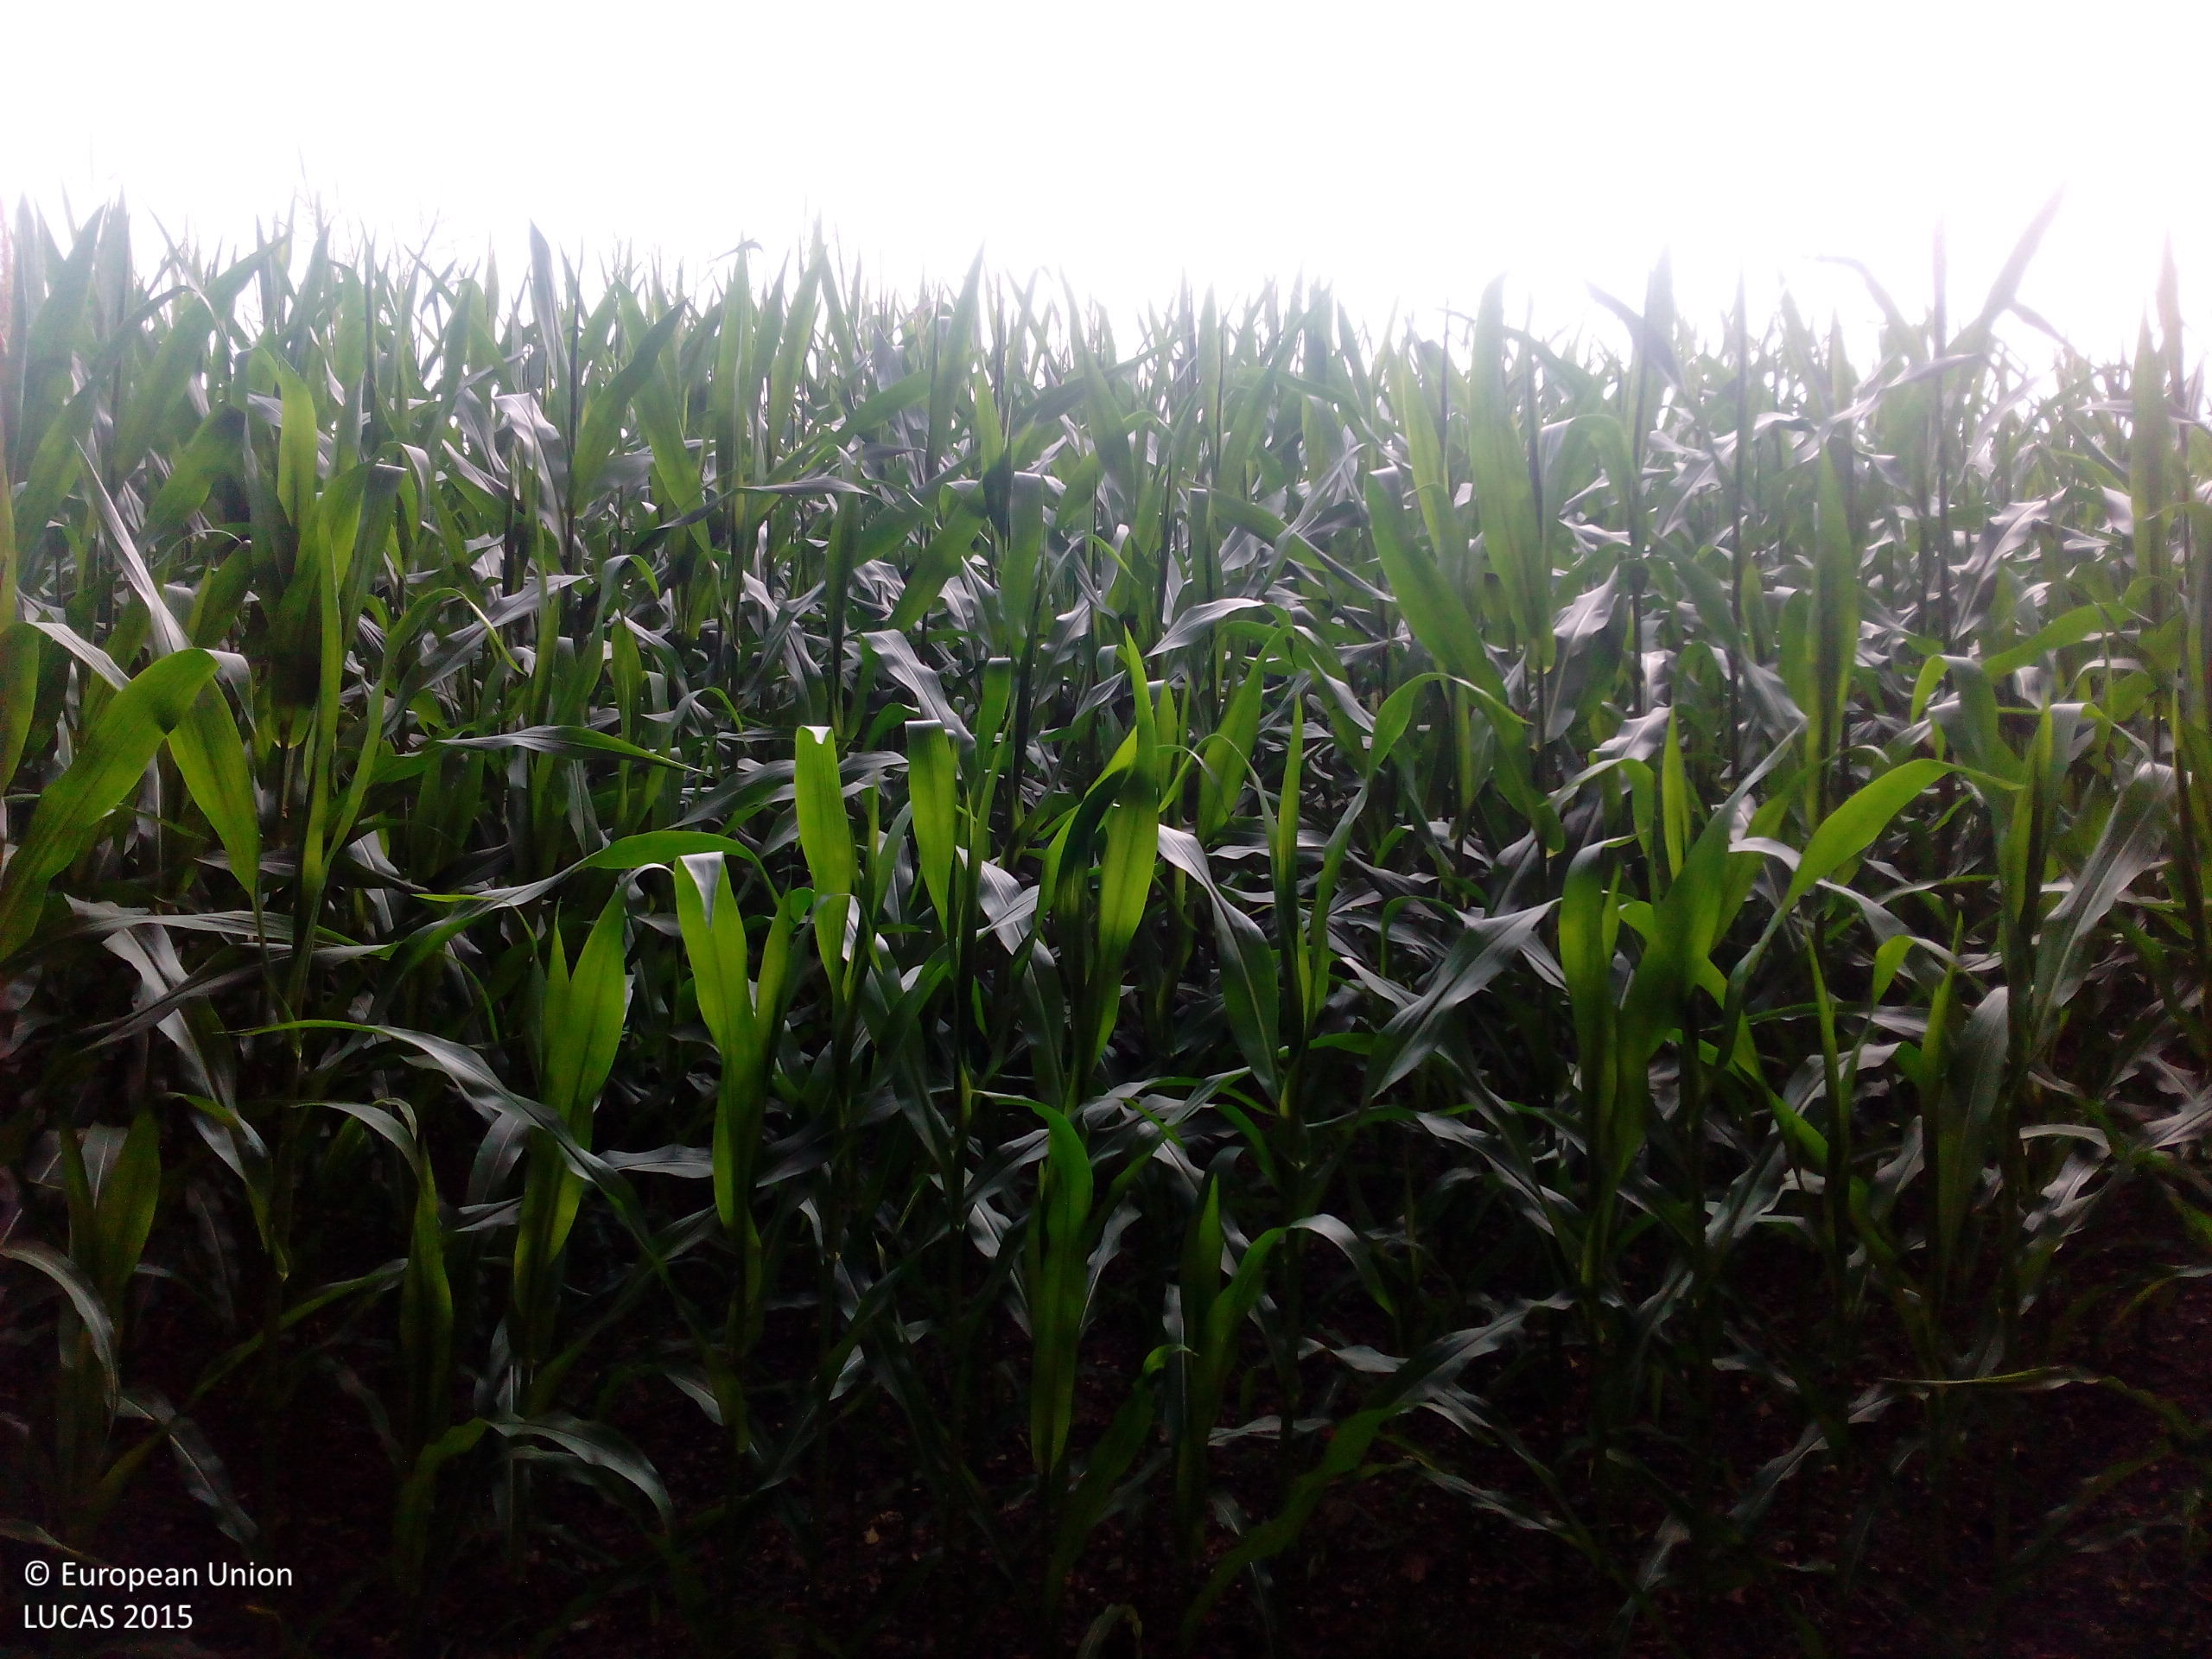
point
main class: Cropland
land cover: Maize
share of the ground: > 75 %
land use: Agriculture (excluding fallow land and kitchen gardens)
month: July
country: DE
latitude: 48.3115
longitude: 12.8981
